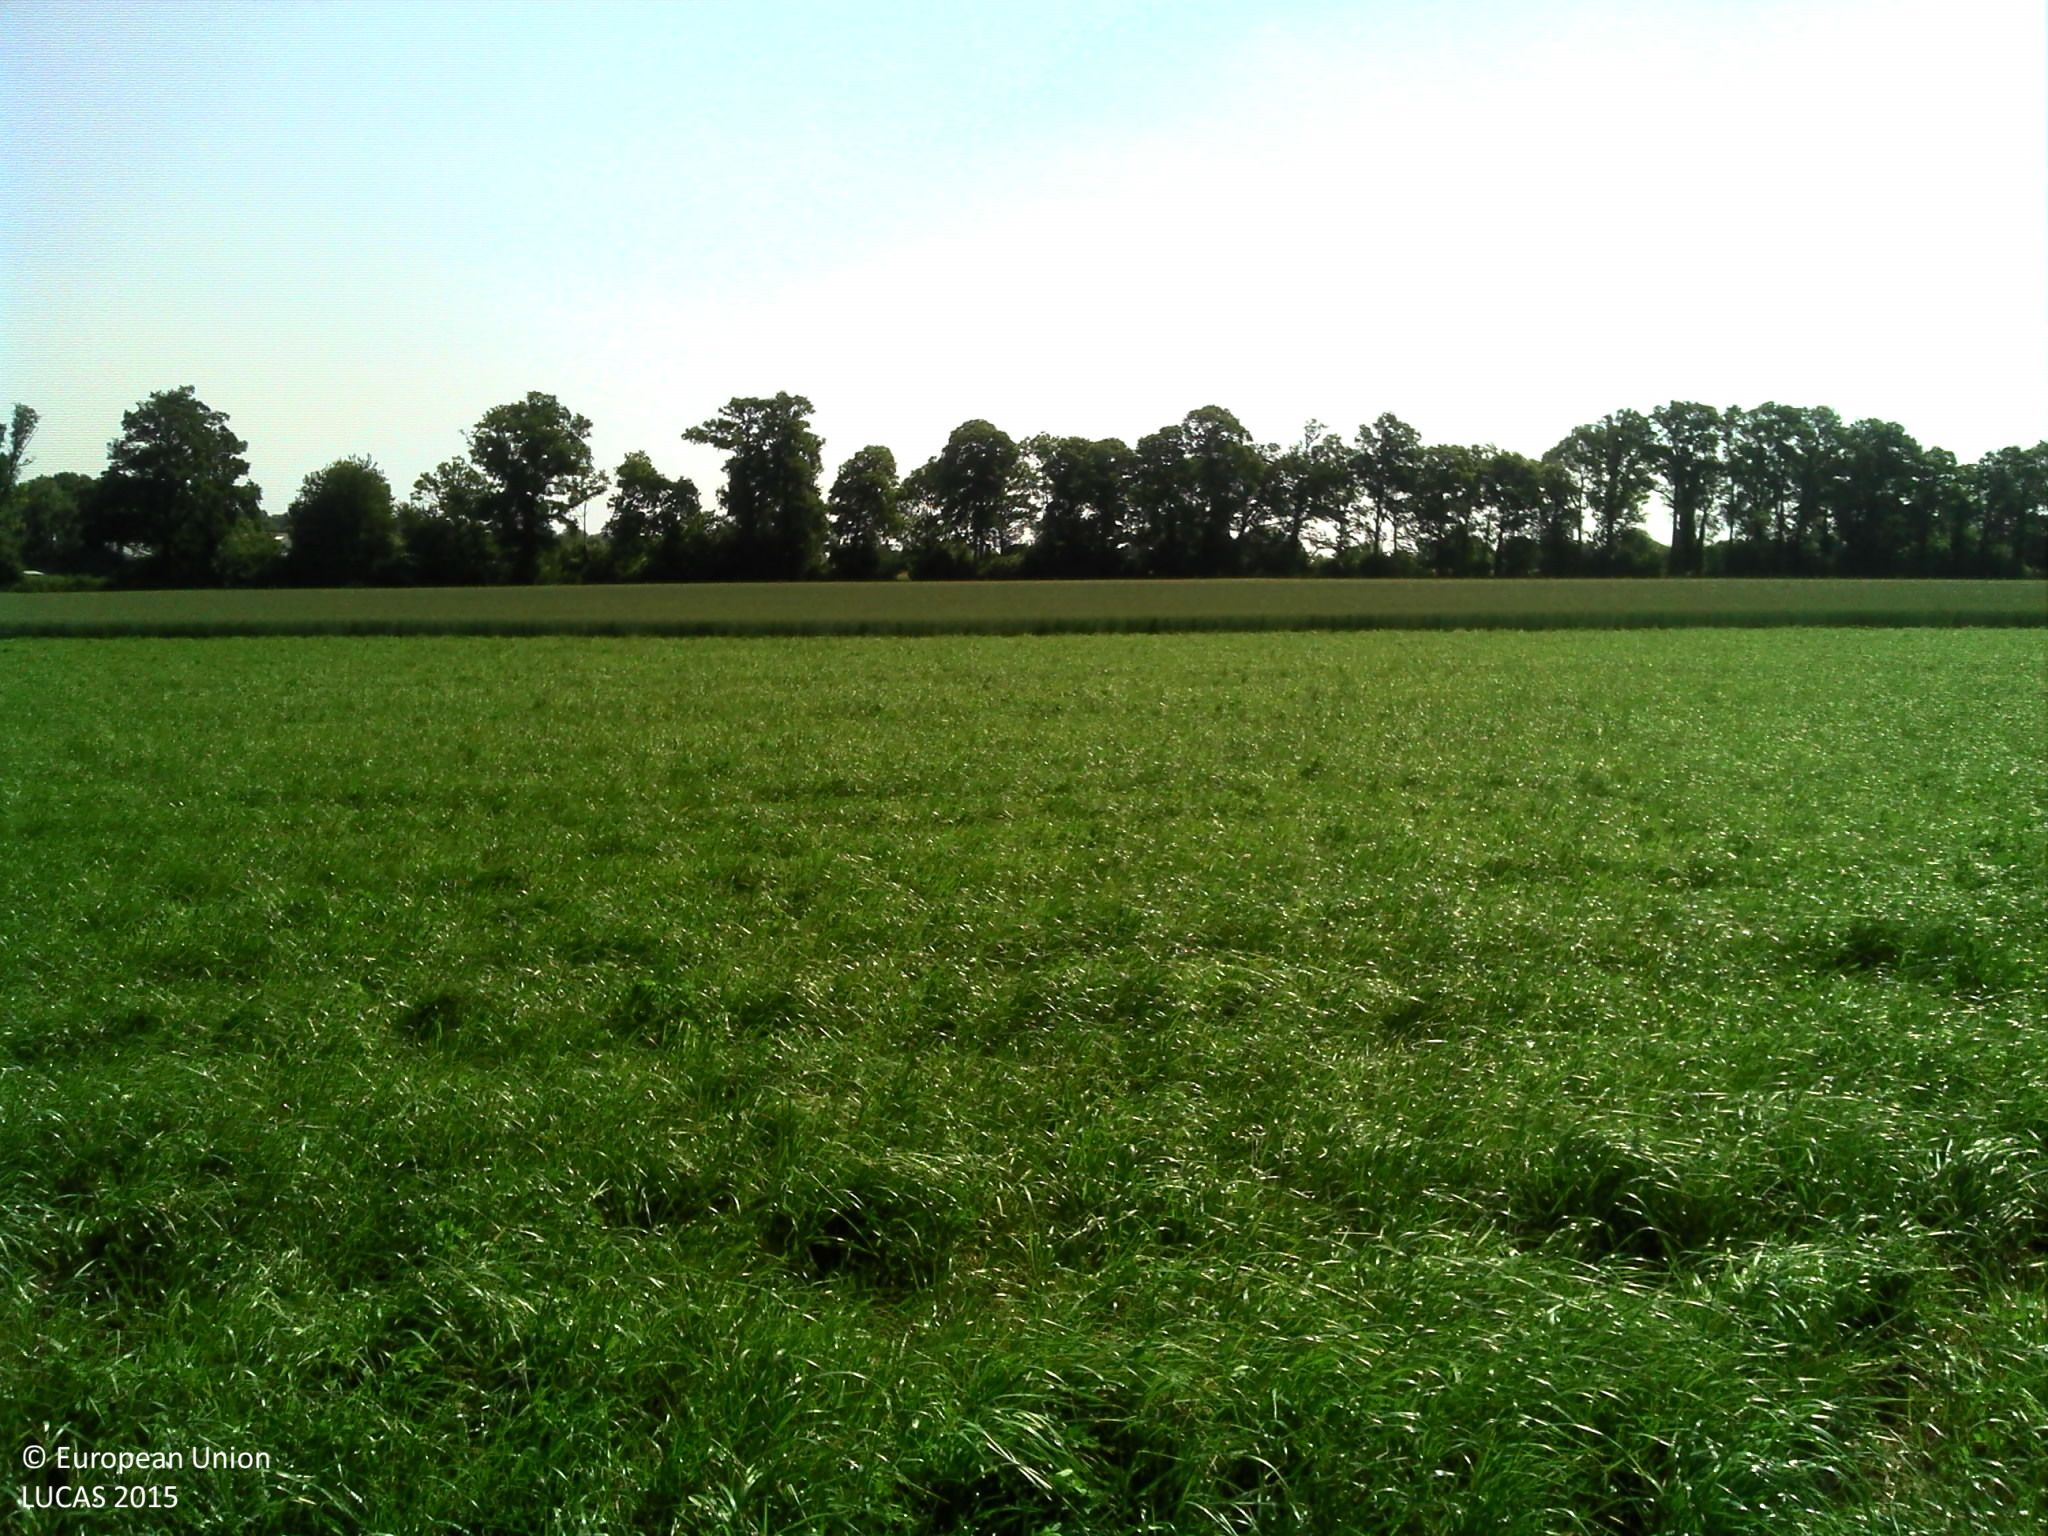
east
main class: Cropland
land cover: Temporary grasslands
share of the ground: > 75 %
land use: Agriculture (excluding fallow land and kitchen gardens)
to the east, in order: Temporary grasslands; Common wheat; Lines of trees; Tracks; Broadleaved woodland; Rye
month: June
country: FR
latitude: 48.0774
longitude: -1.1142
